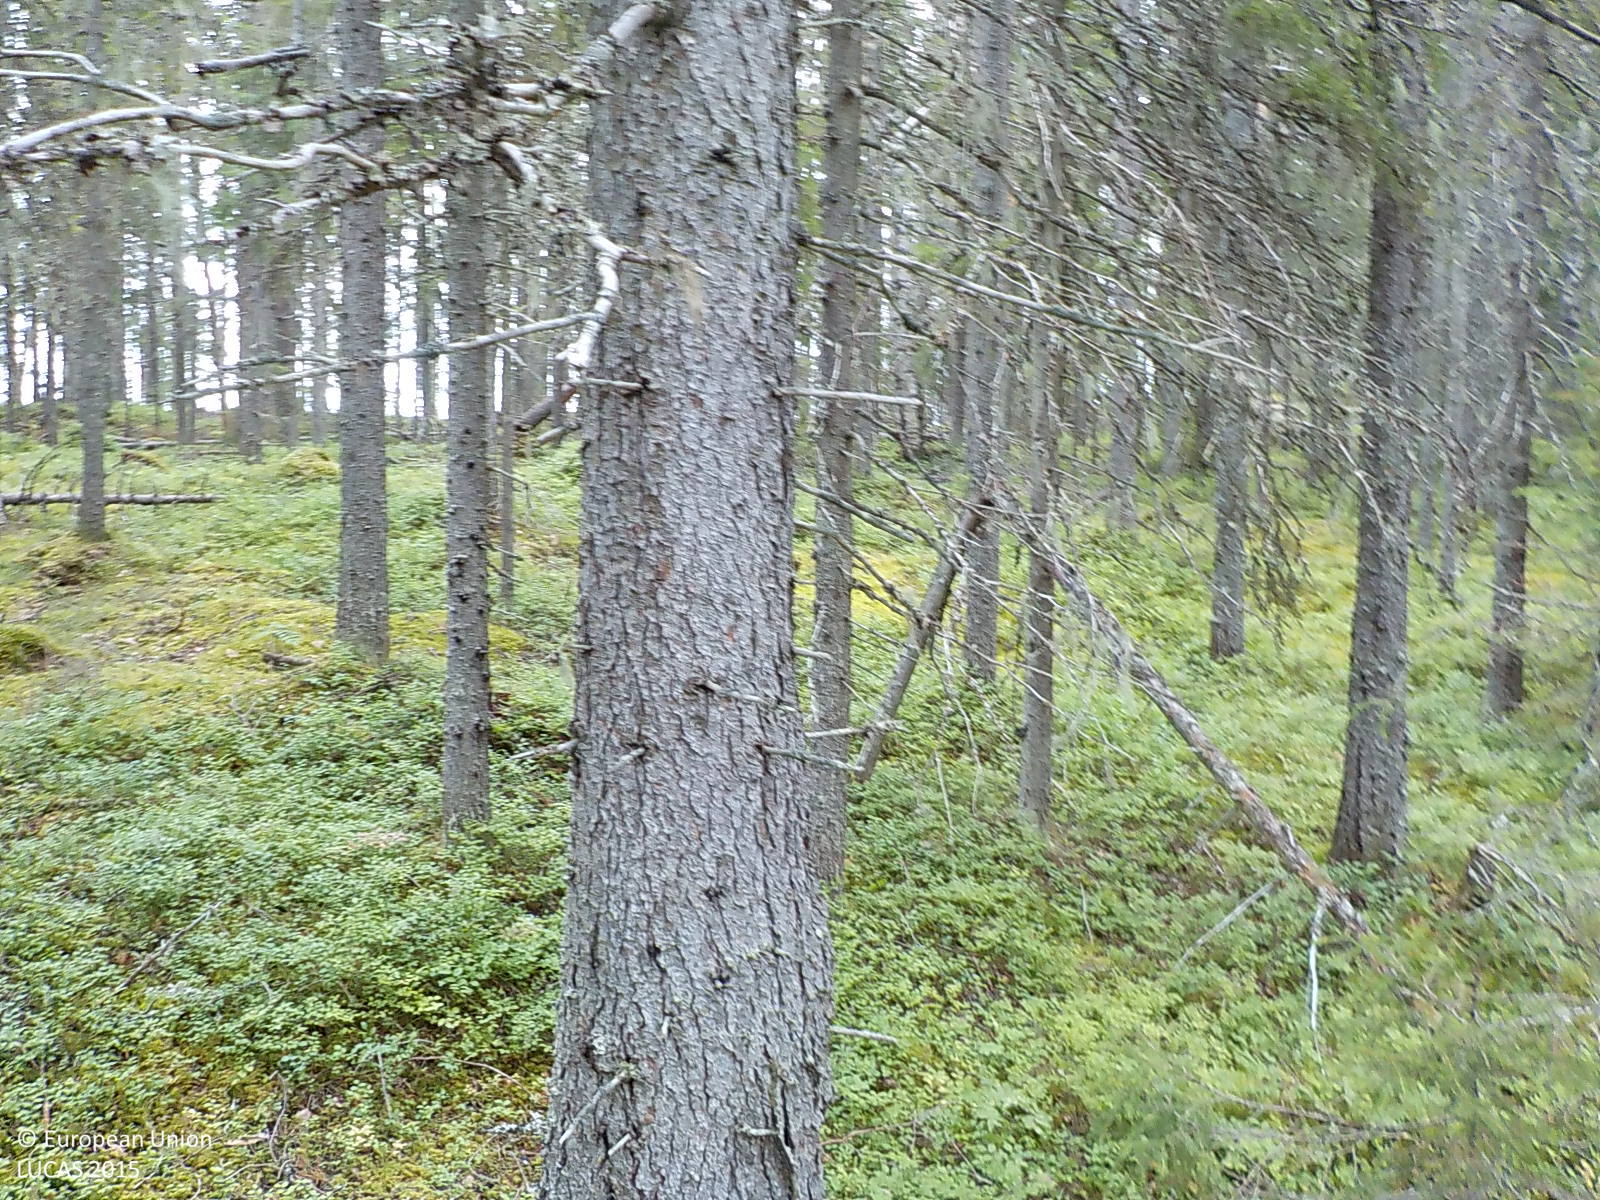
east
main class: Woodland
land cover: Spruce dominated coniferous woodland
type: boreal forest
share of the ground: > 75 %
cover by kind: coniferous forest trees 85 %, shrubs 15 %
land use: Forestry
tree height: > 5 m
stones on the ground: 10 - 25 %
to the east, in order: Spruce dominated coniferous woodland; Other mixed woodland
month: September
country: SE
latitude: 63.2781
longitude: 17.8496
